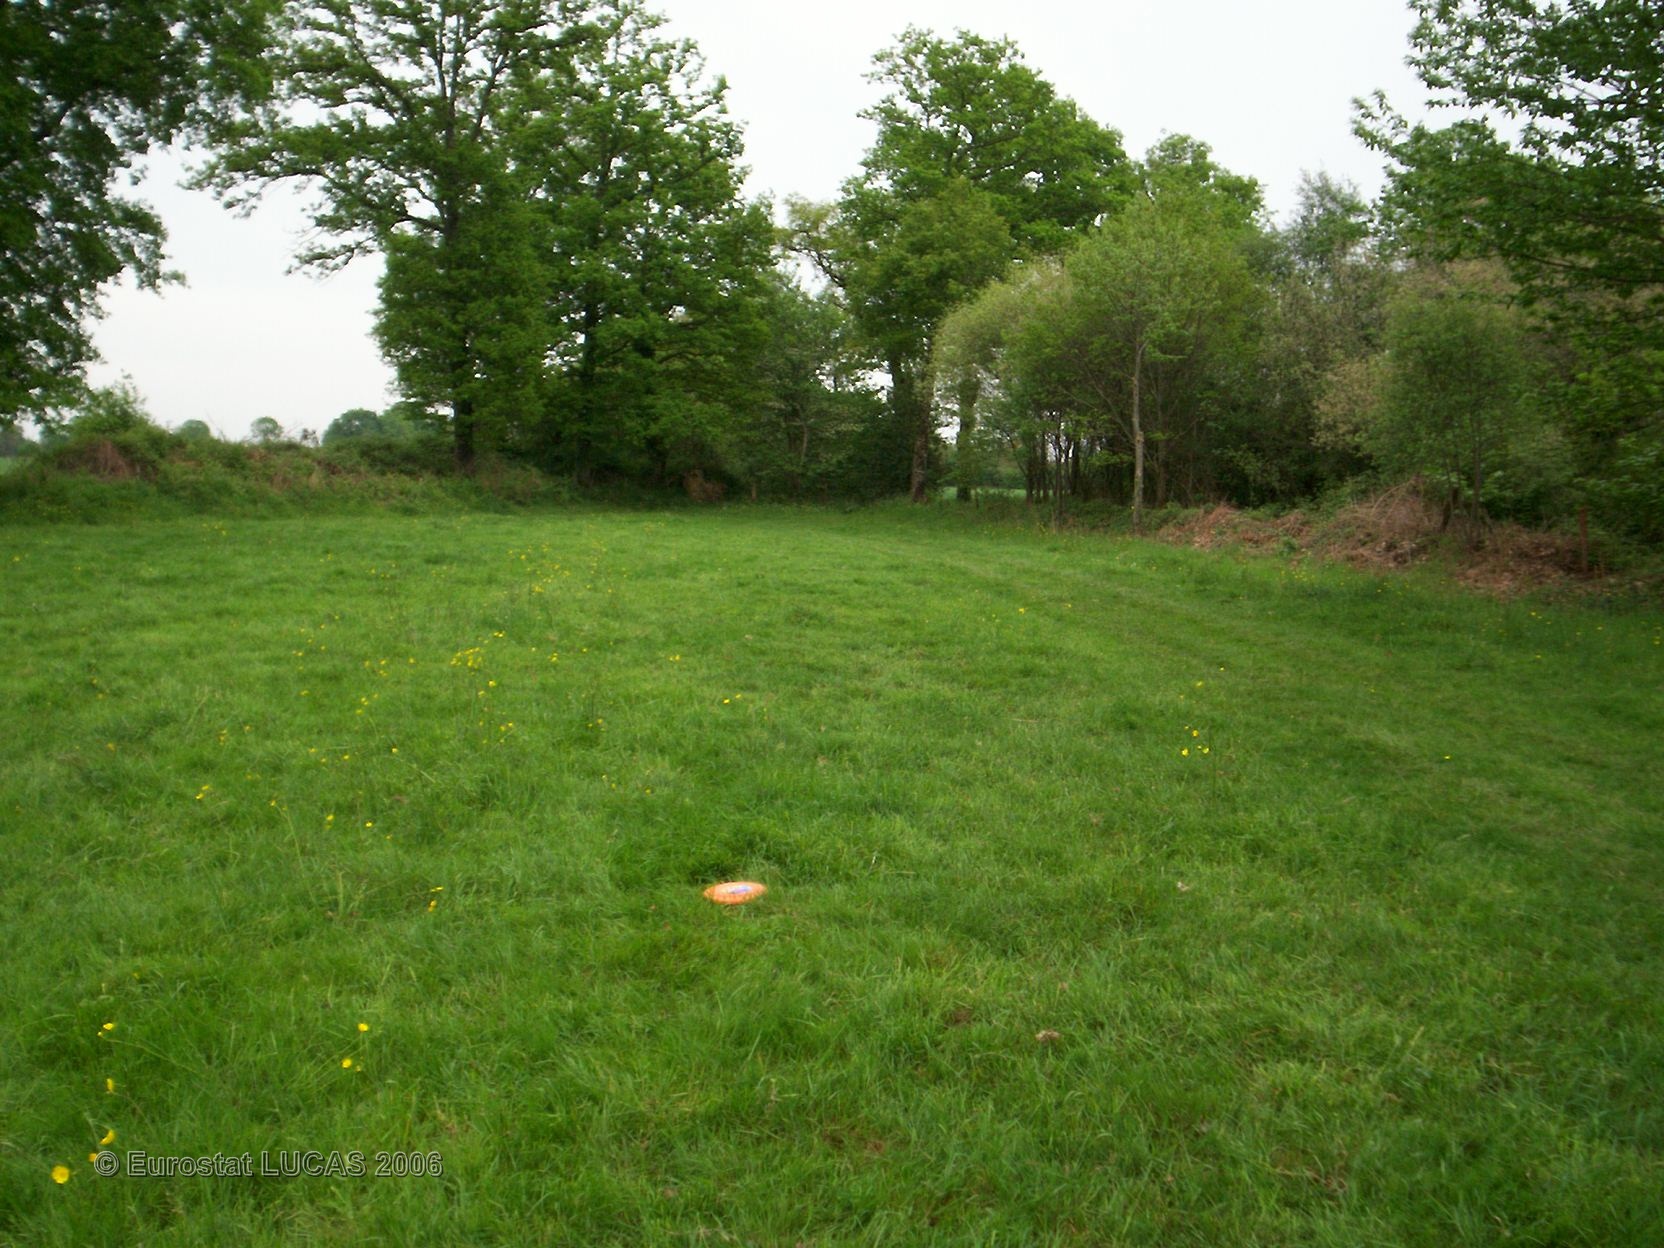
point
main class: Grassland
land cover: Grassland without tree/shrub cover
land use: Agriculture (excluding fallow land and kitchen gardens)
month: May
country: FR
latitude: 48.2938
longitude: -1.6540
